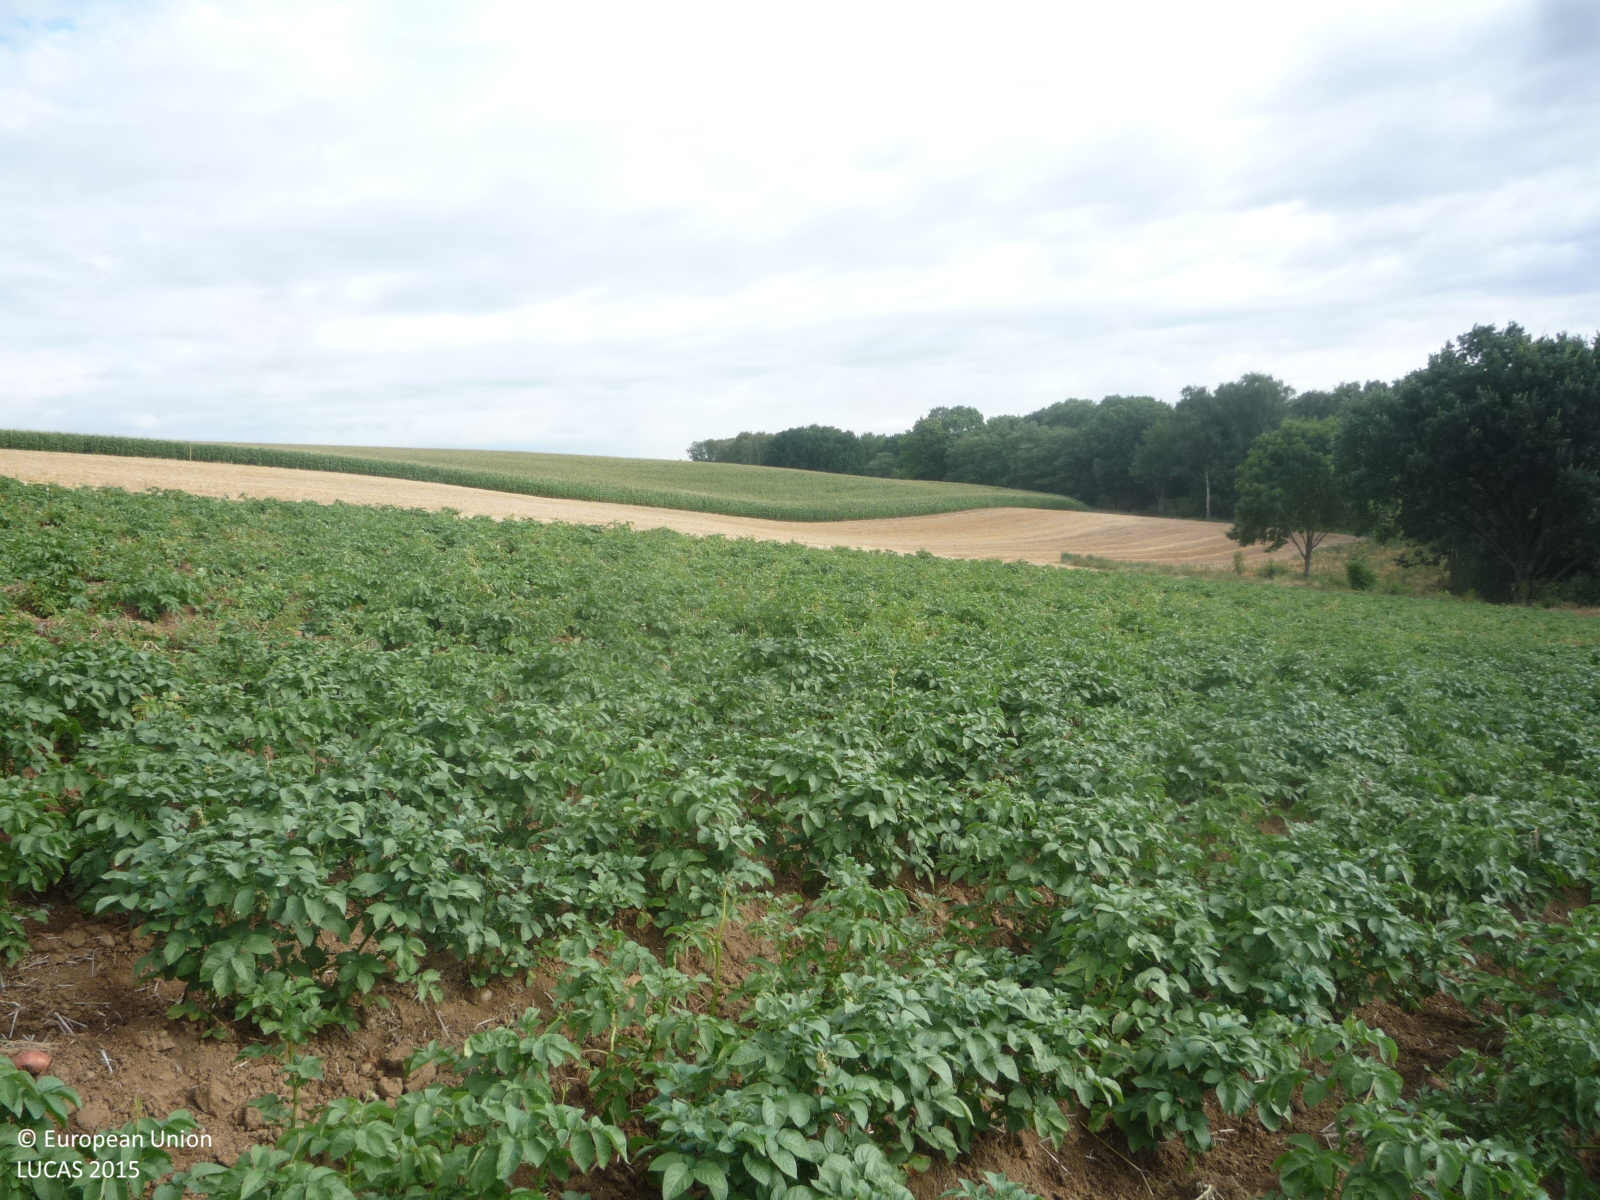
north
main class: Cropland
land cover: Potatoes
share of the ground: > 75 %
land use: Agriculture (excluding fallow land and kitchen gardens)
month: July
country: CZ
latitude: 50.4069
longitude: 15.2236
